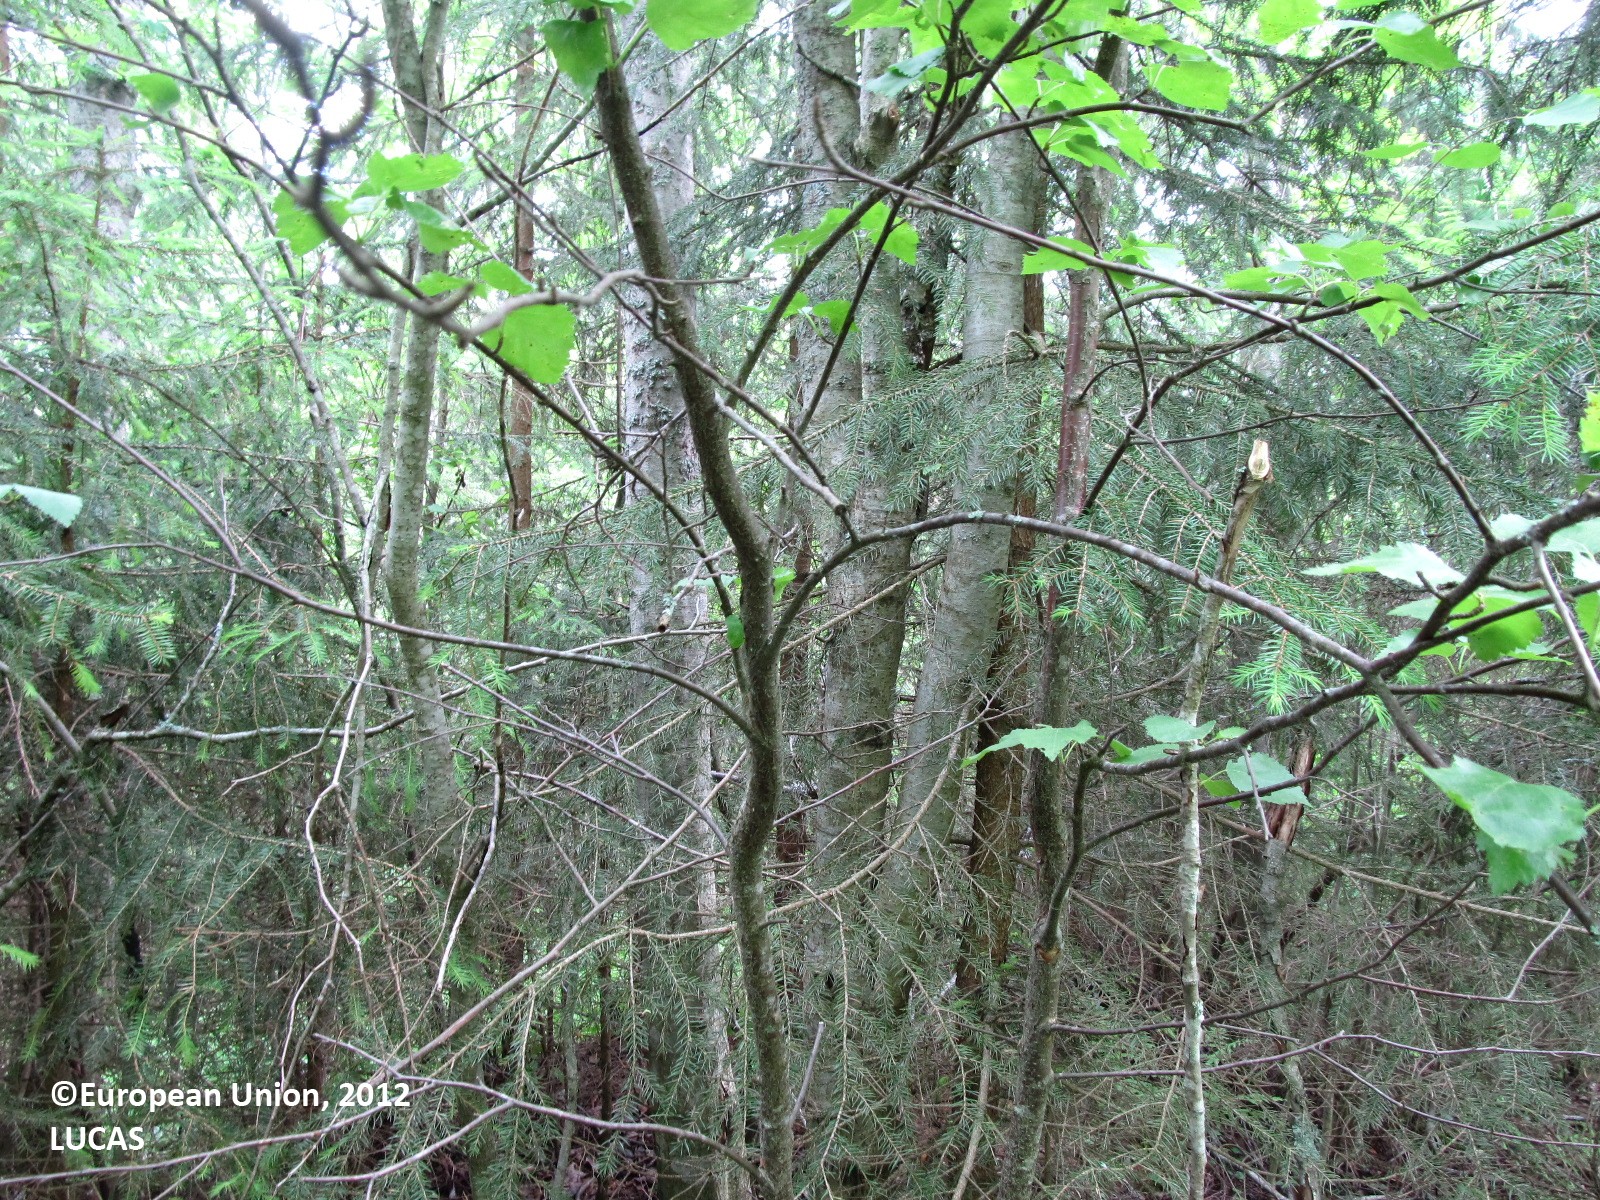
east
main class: Woodland
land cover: Spruce dominated mixed woodland
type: boreal forest
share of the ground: 50 - 75 %
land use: Forestry
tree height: > 5 m
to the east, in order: Spruce dominated mixed woodland; Ditches and canals; Spruce dominated mixed woodland; Broadleaved woodland; Spruce dominated mixed woodland; Grassland without tree/shrub cover; Broadleaved woodland; Spruce dominated coniferous woodland
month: June
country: FI
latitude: 63.2143
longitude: 27.7701
